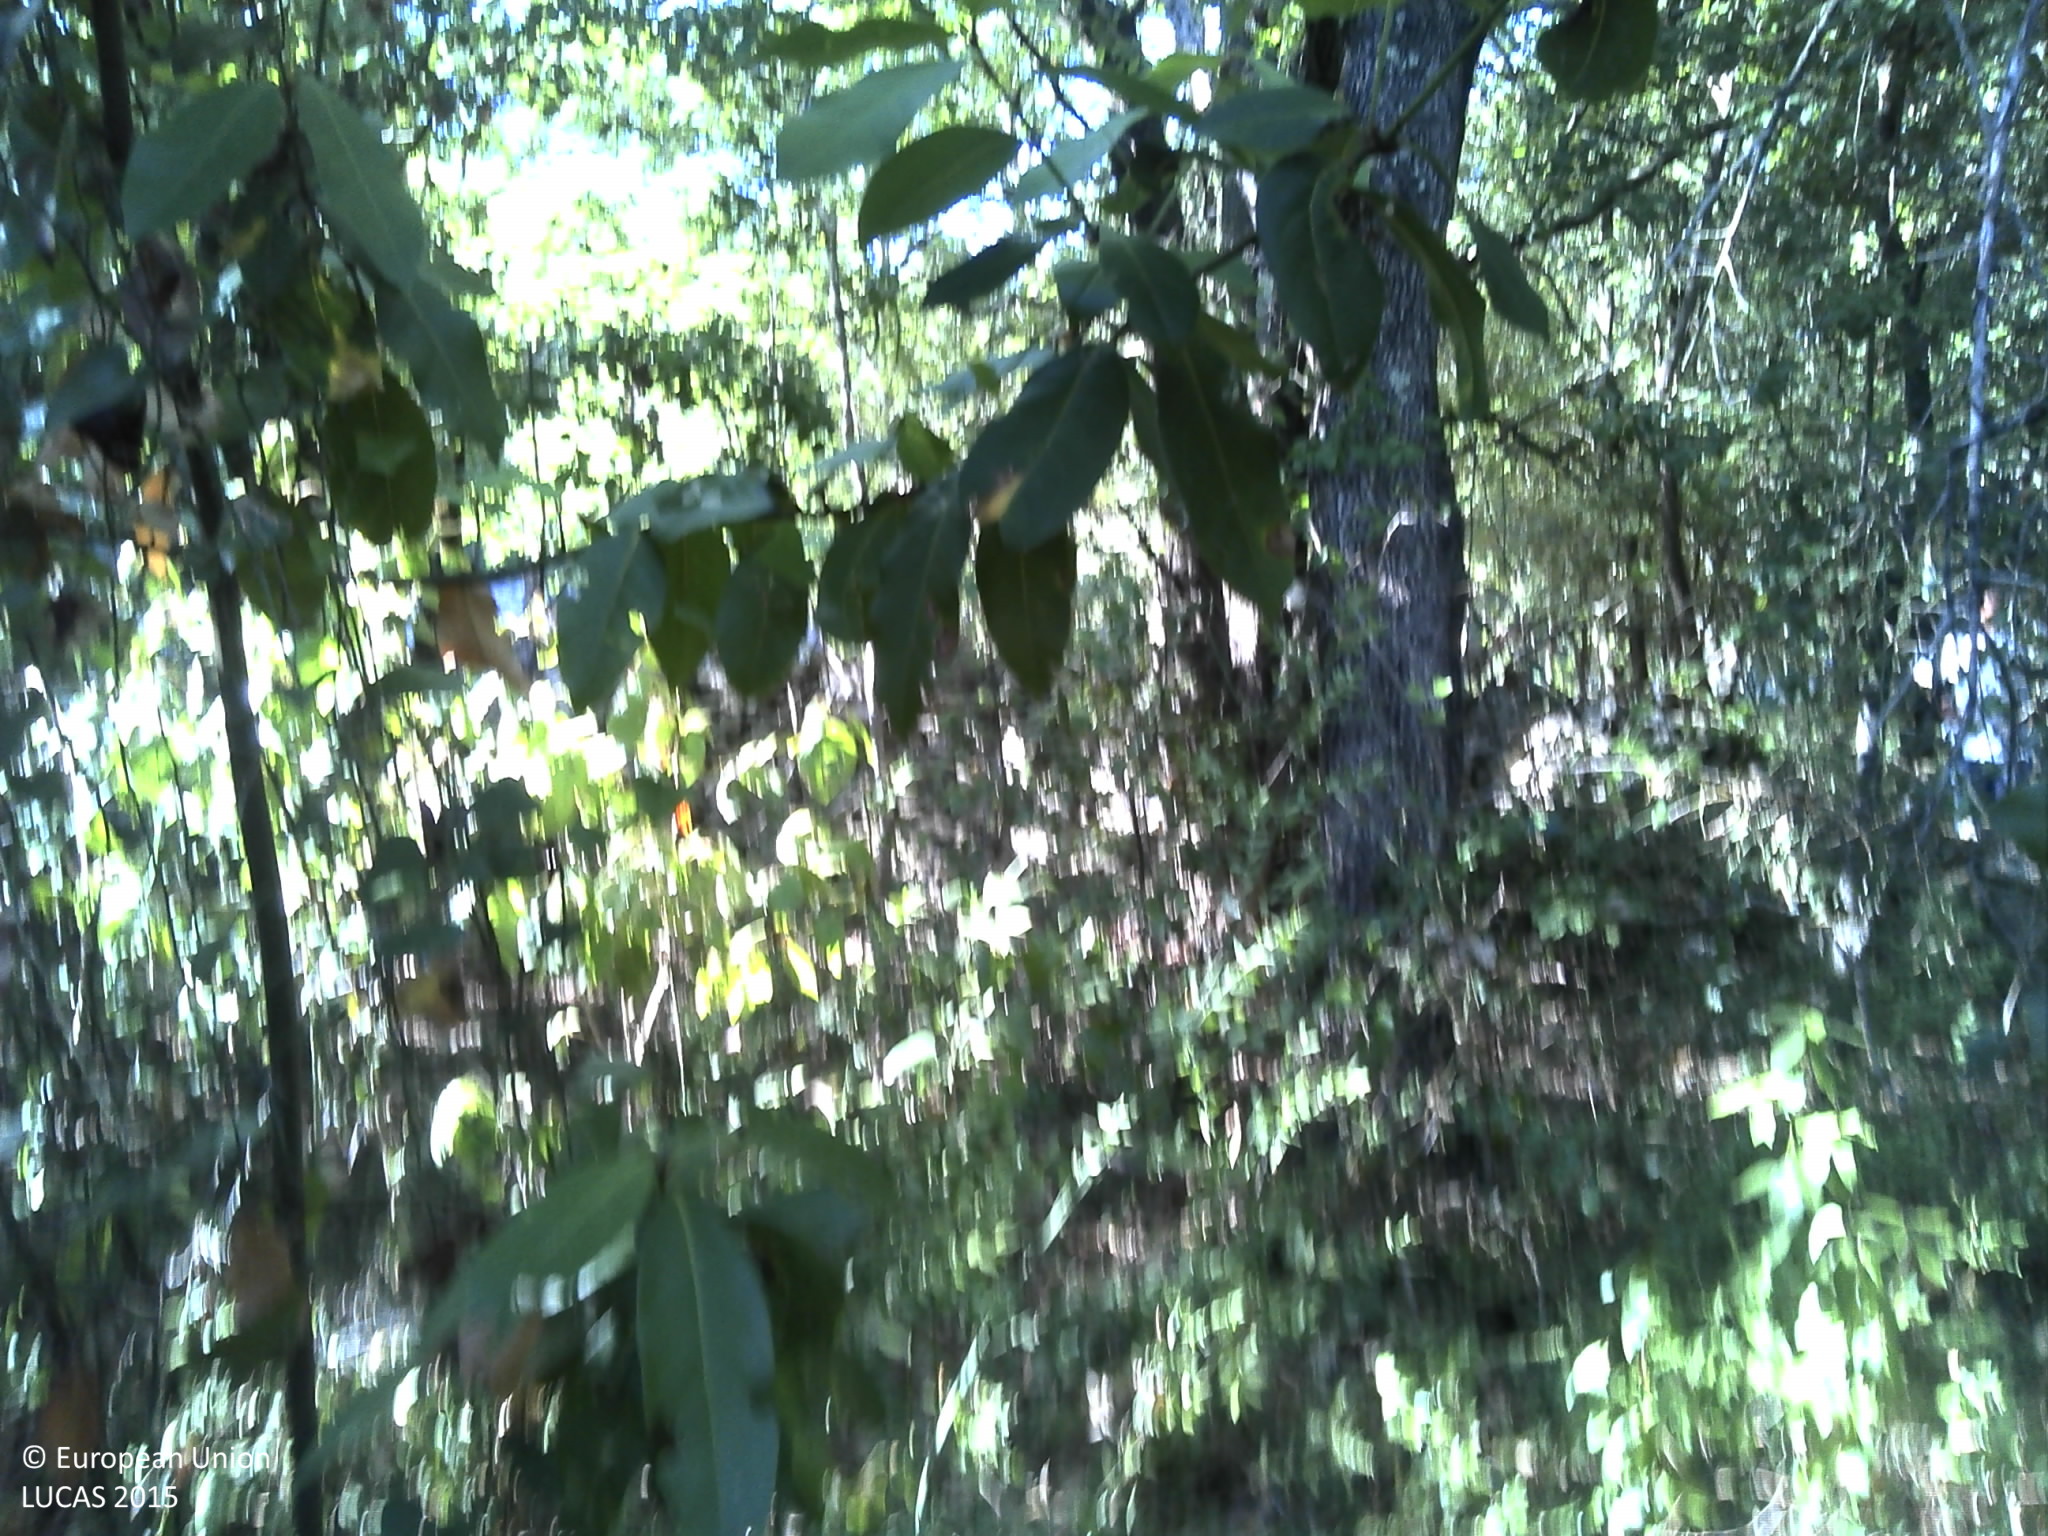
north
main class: Woodland
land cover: Broadleaved woodland
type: acidophilous oak and oak-birch forest
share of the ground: > 75 %
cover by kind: broadleaved forest trees 80 %, herbaceous plants 10 %, unconsolidated bare surface 10 %
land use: Semi-natural and natural areas not in use
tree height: > 5 m
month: July
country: FR
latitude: 43.6356
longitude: 3.1534
